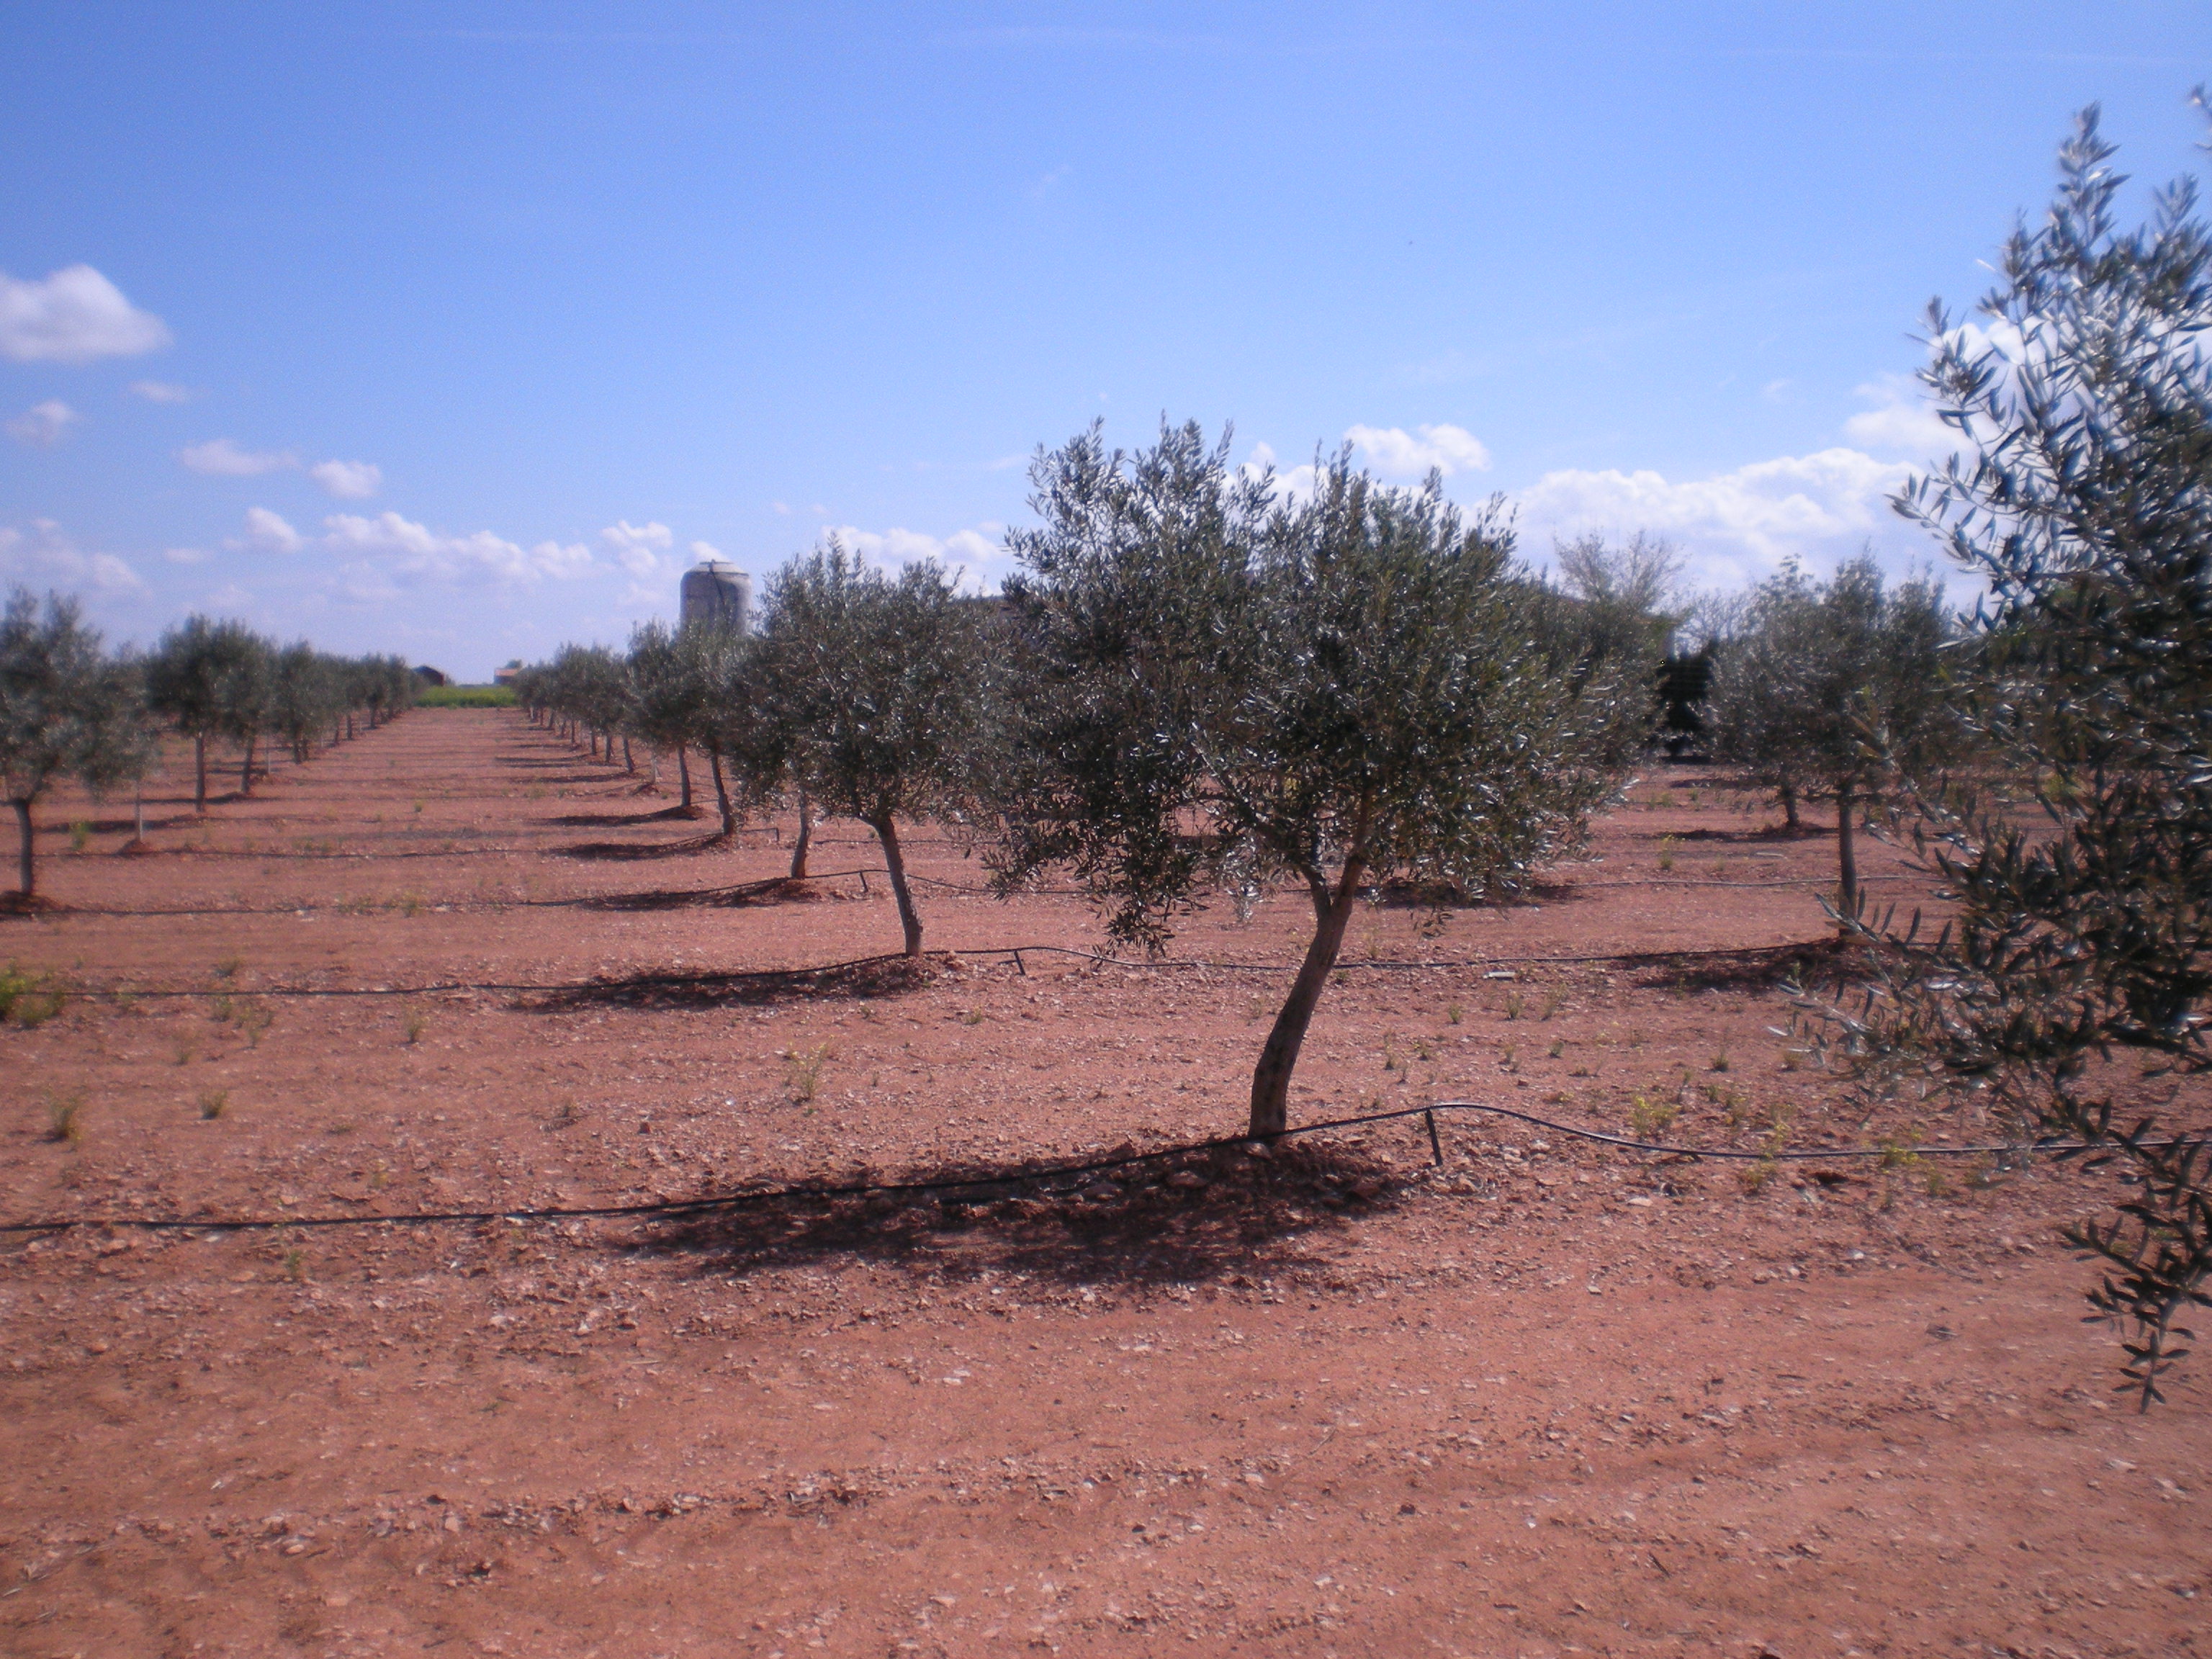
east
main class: Cropland
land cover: Olive groves
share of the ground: < 10 %
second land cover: Other bare soil
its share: > 75 %
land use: Agriculture (excluding fallow land and kitchen gardens)
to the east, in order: Olive groves; Other bare soil; Fences; Conifer hedges; Artificial constructions in urban areas; Conifer hedges; Fences; Olive groves; Barley; Grass margins; Barley
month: April
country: ES
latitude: 38.9494
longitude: -3.5968
